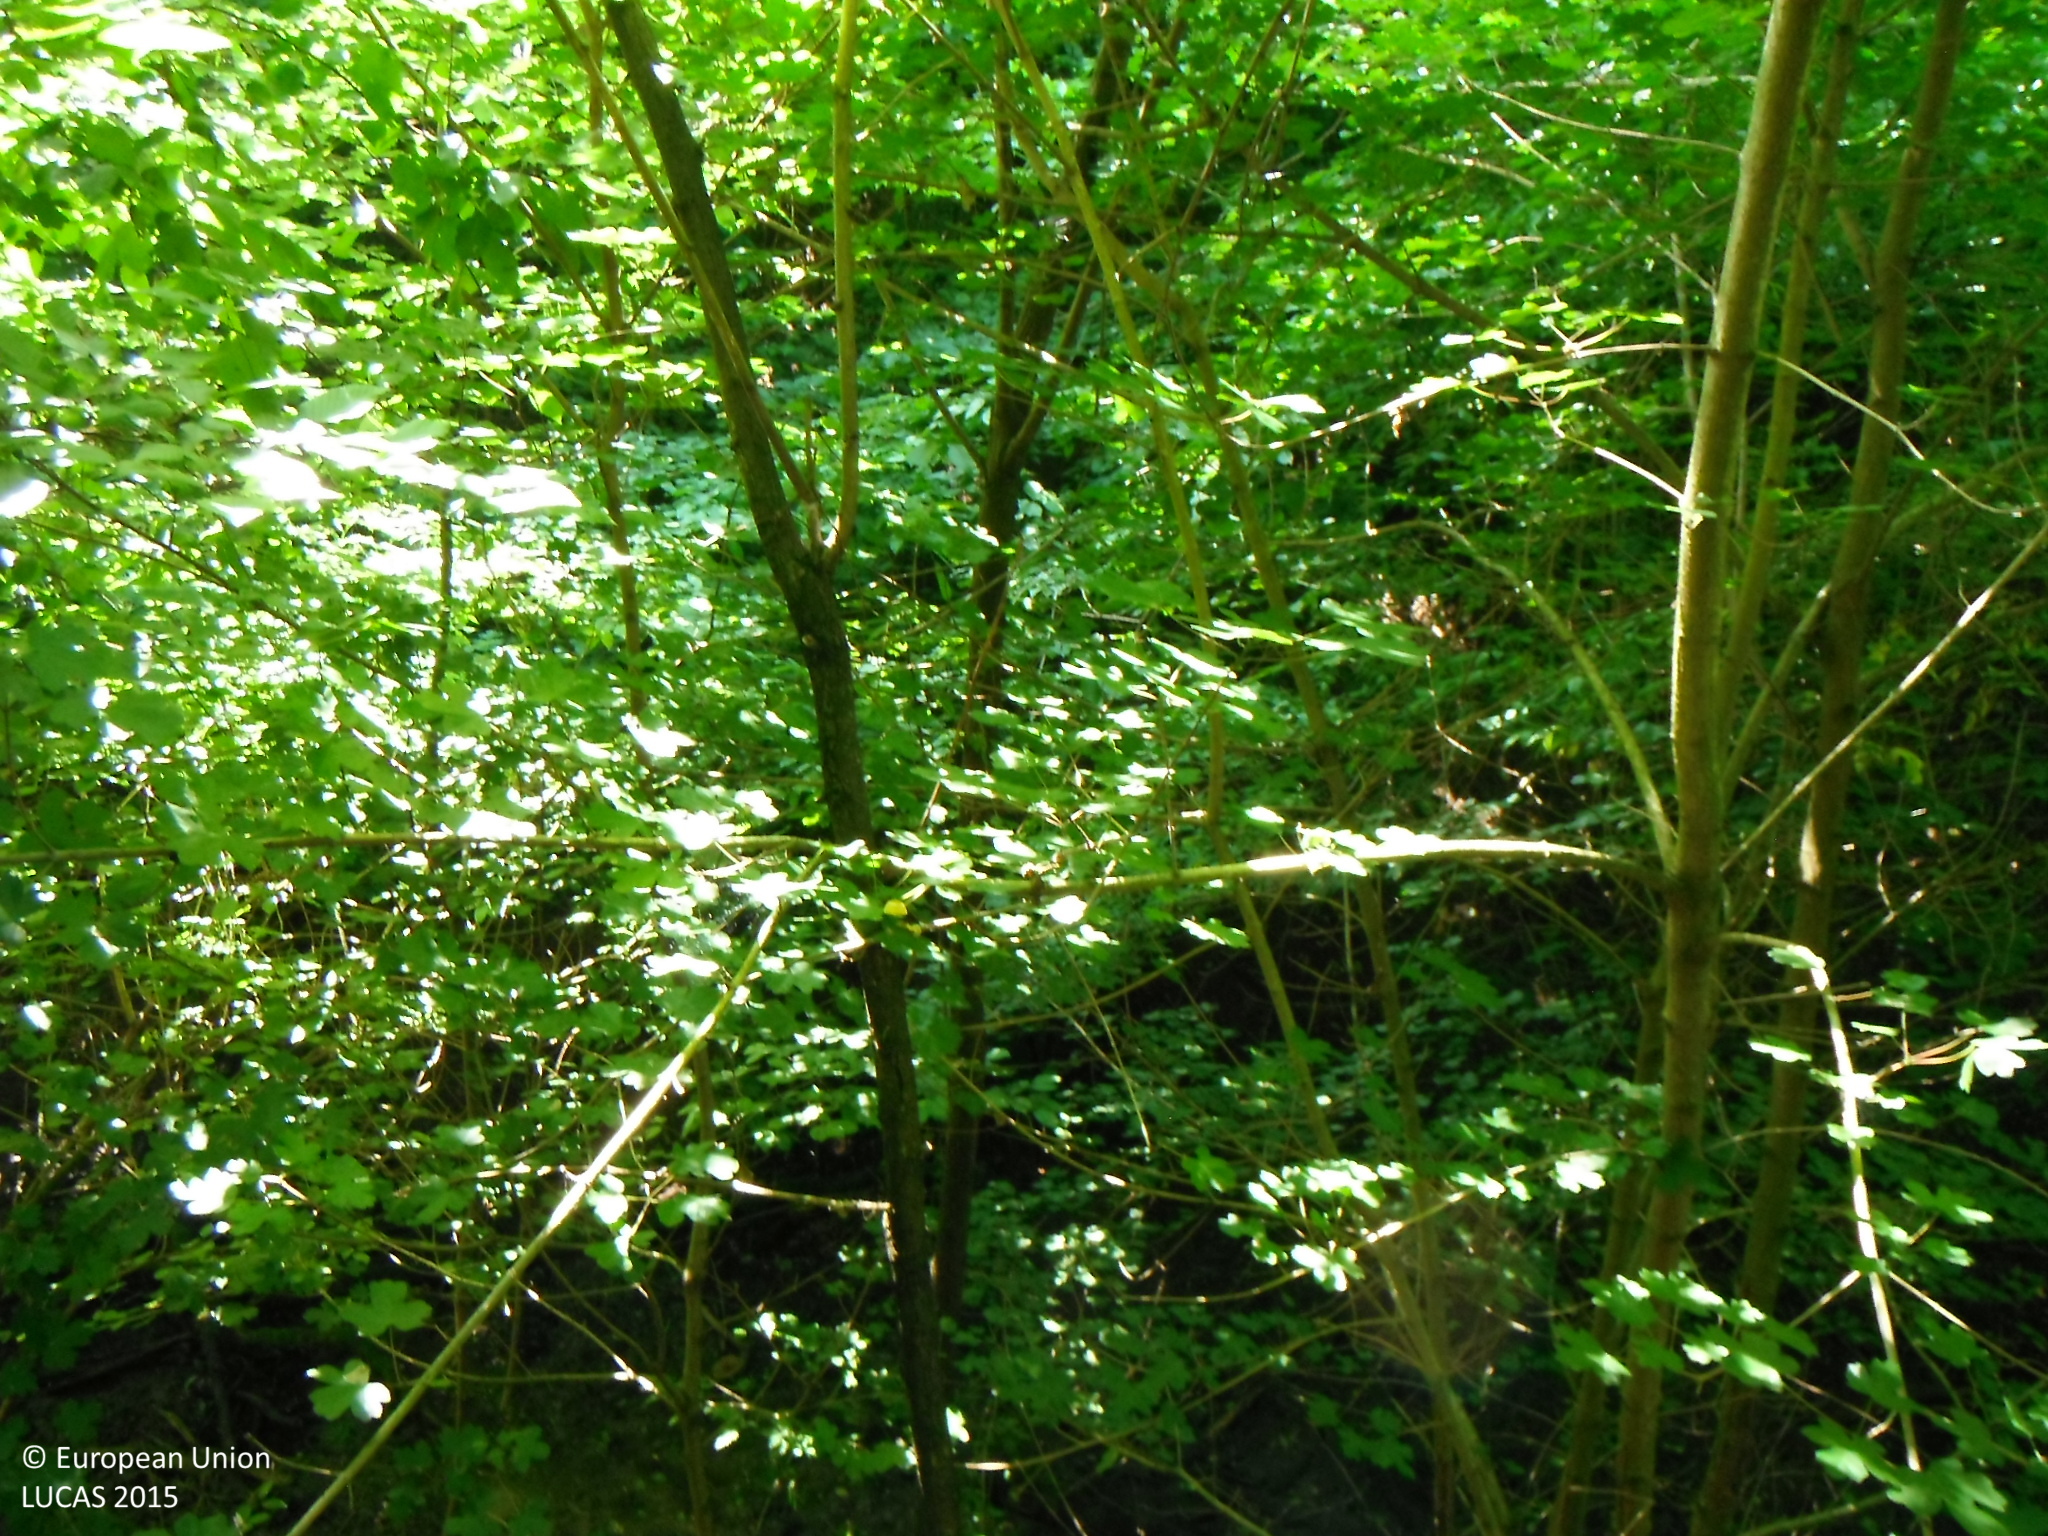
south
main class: Woodland
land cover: Broadleaved woodland
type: mesophytic deciduous forest
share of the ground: > 75 %
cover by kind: broadleaved forest trees 95 %, herbaceous plants 5 %
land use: Forestry
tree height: > 5 m
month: July
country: SK
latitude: 48.1657
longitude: 19.3945
